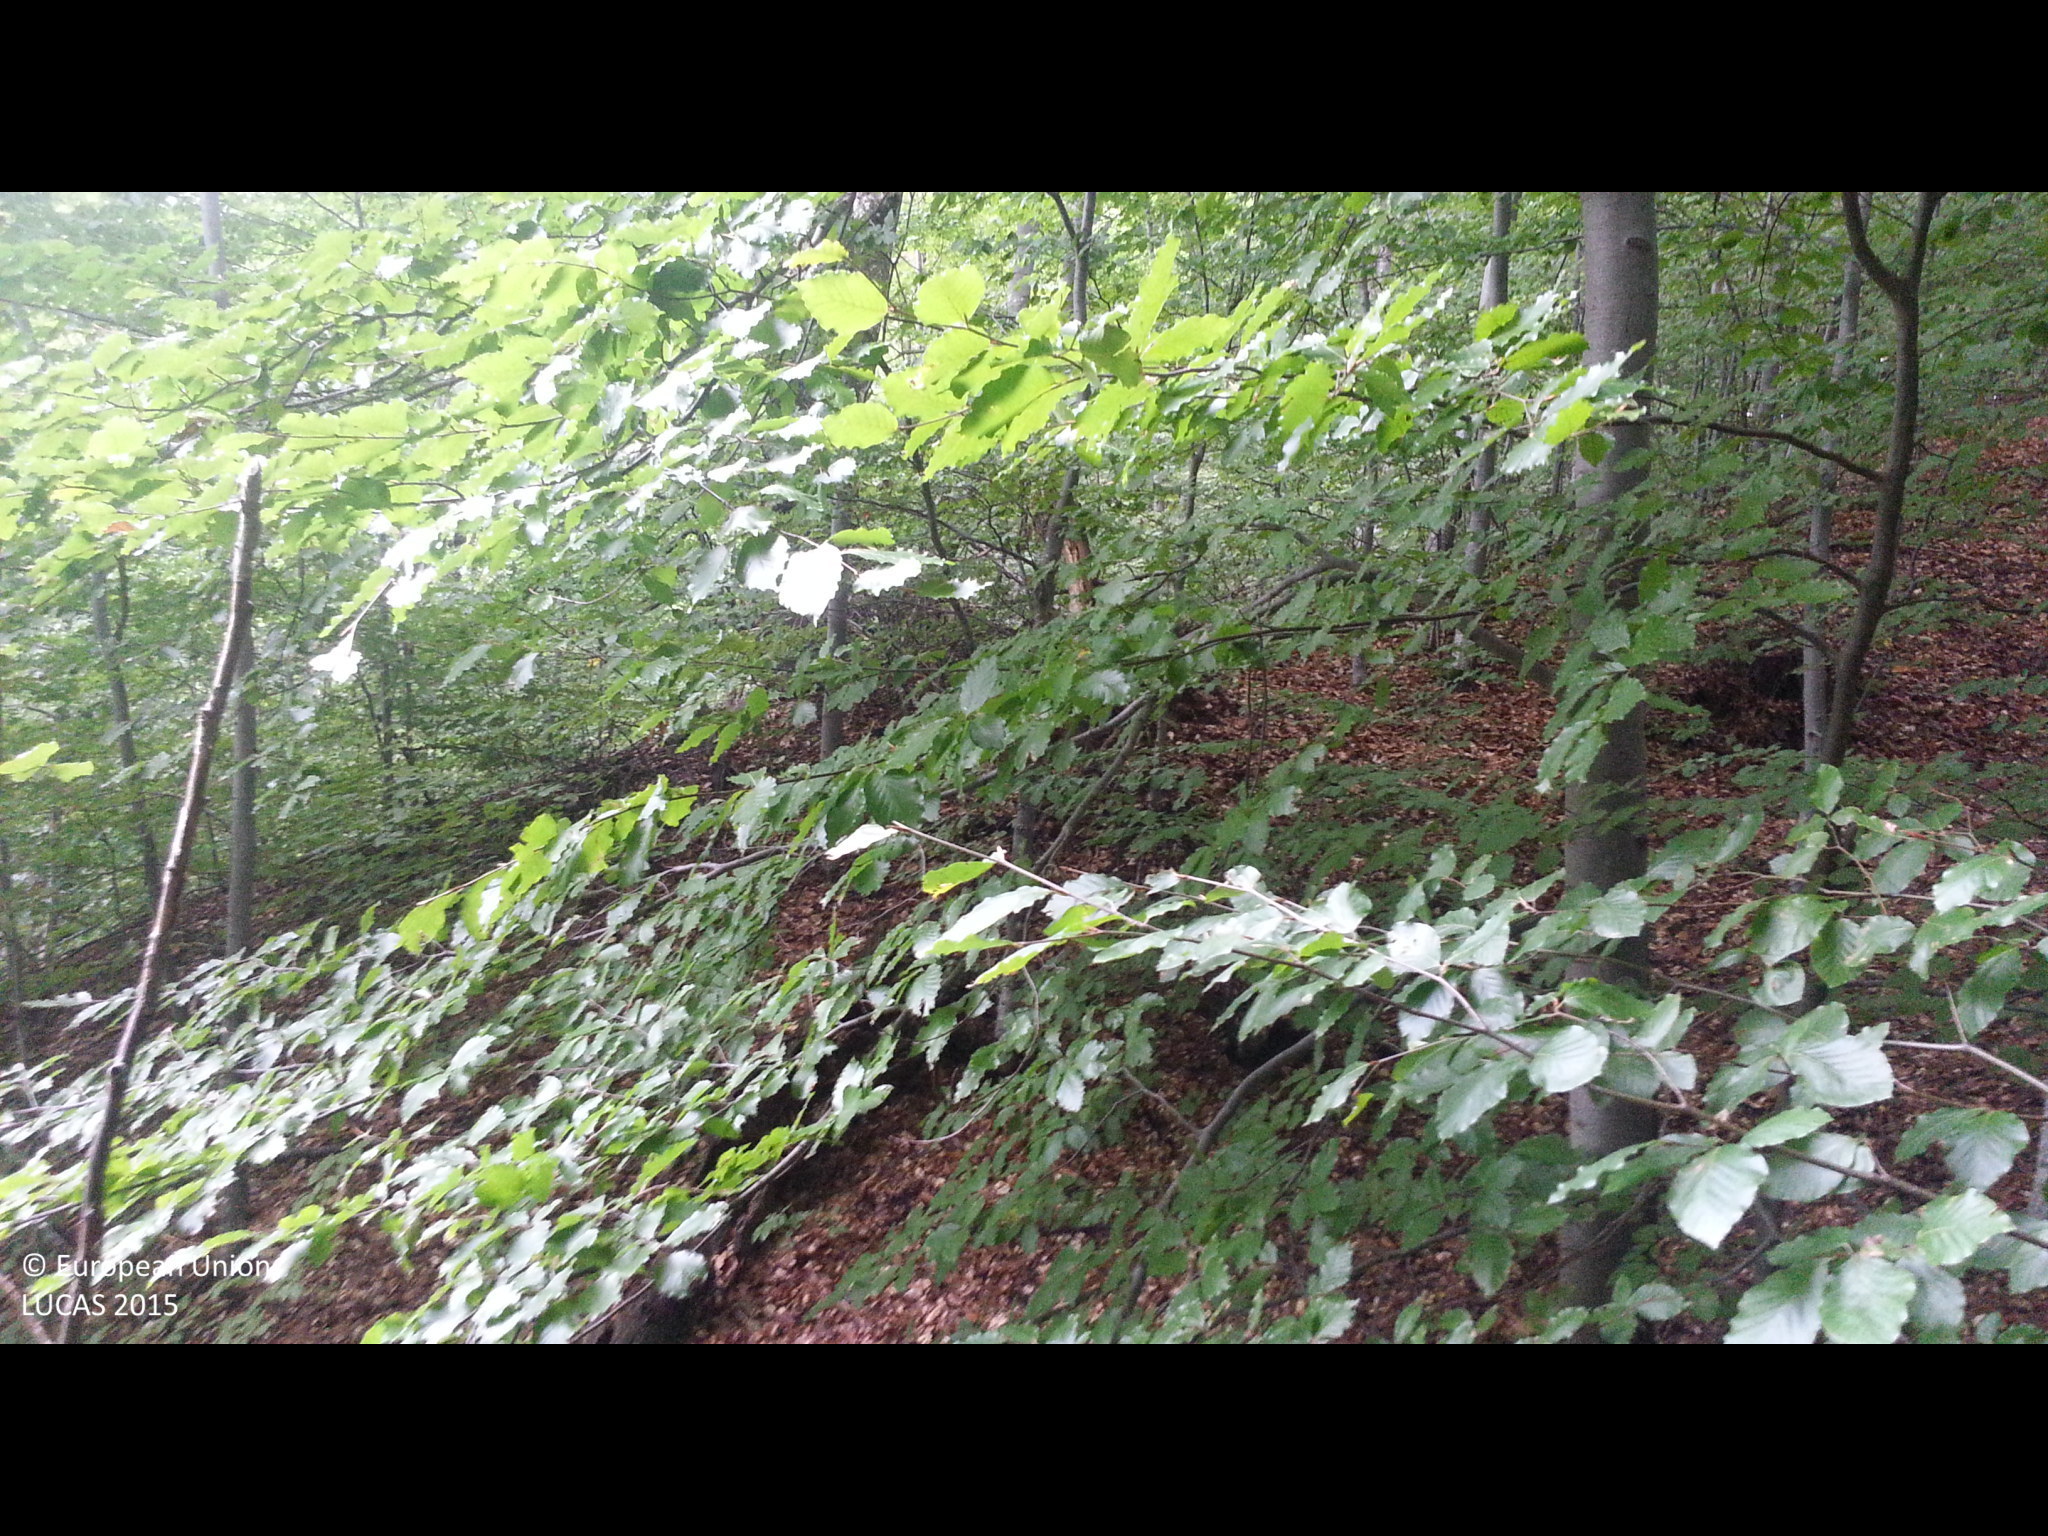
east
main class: Woodland
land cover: Broadleaved woodland
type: mountainous beech forest
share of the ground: > 75 %
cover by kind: broadleaved forest trees 95 %, shrubs 5 %
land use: Forestry
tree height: > 5 m
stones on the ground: < 10 %
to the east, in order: Broadleaved woodland; Shrubland with sparse tree cover
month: September
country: BG
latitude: 42.3998
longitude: 22.5468
